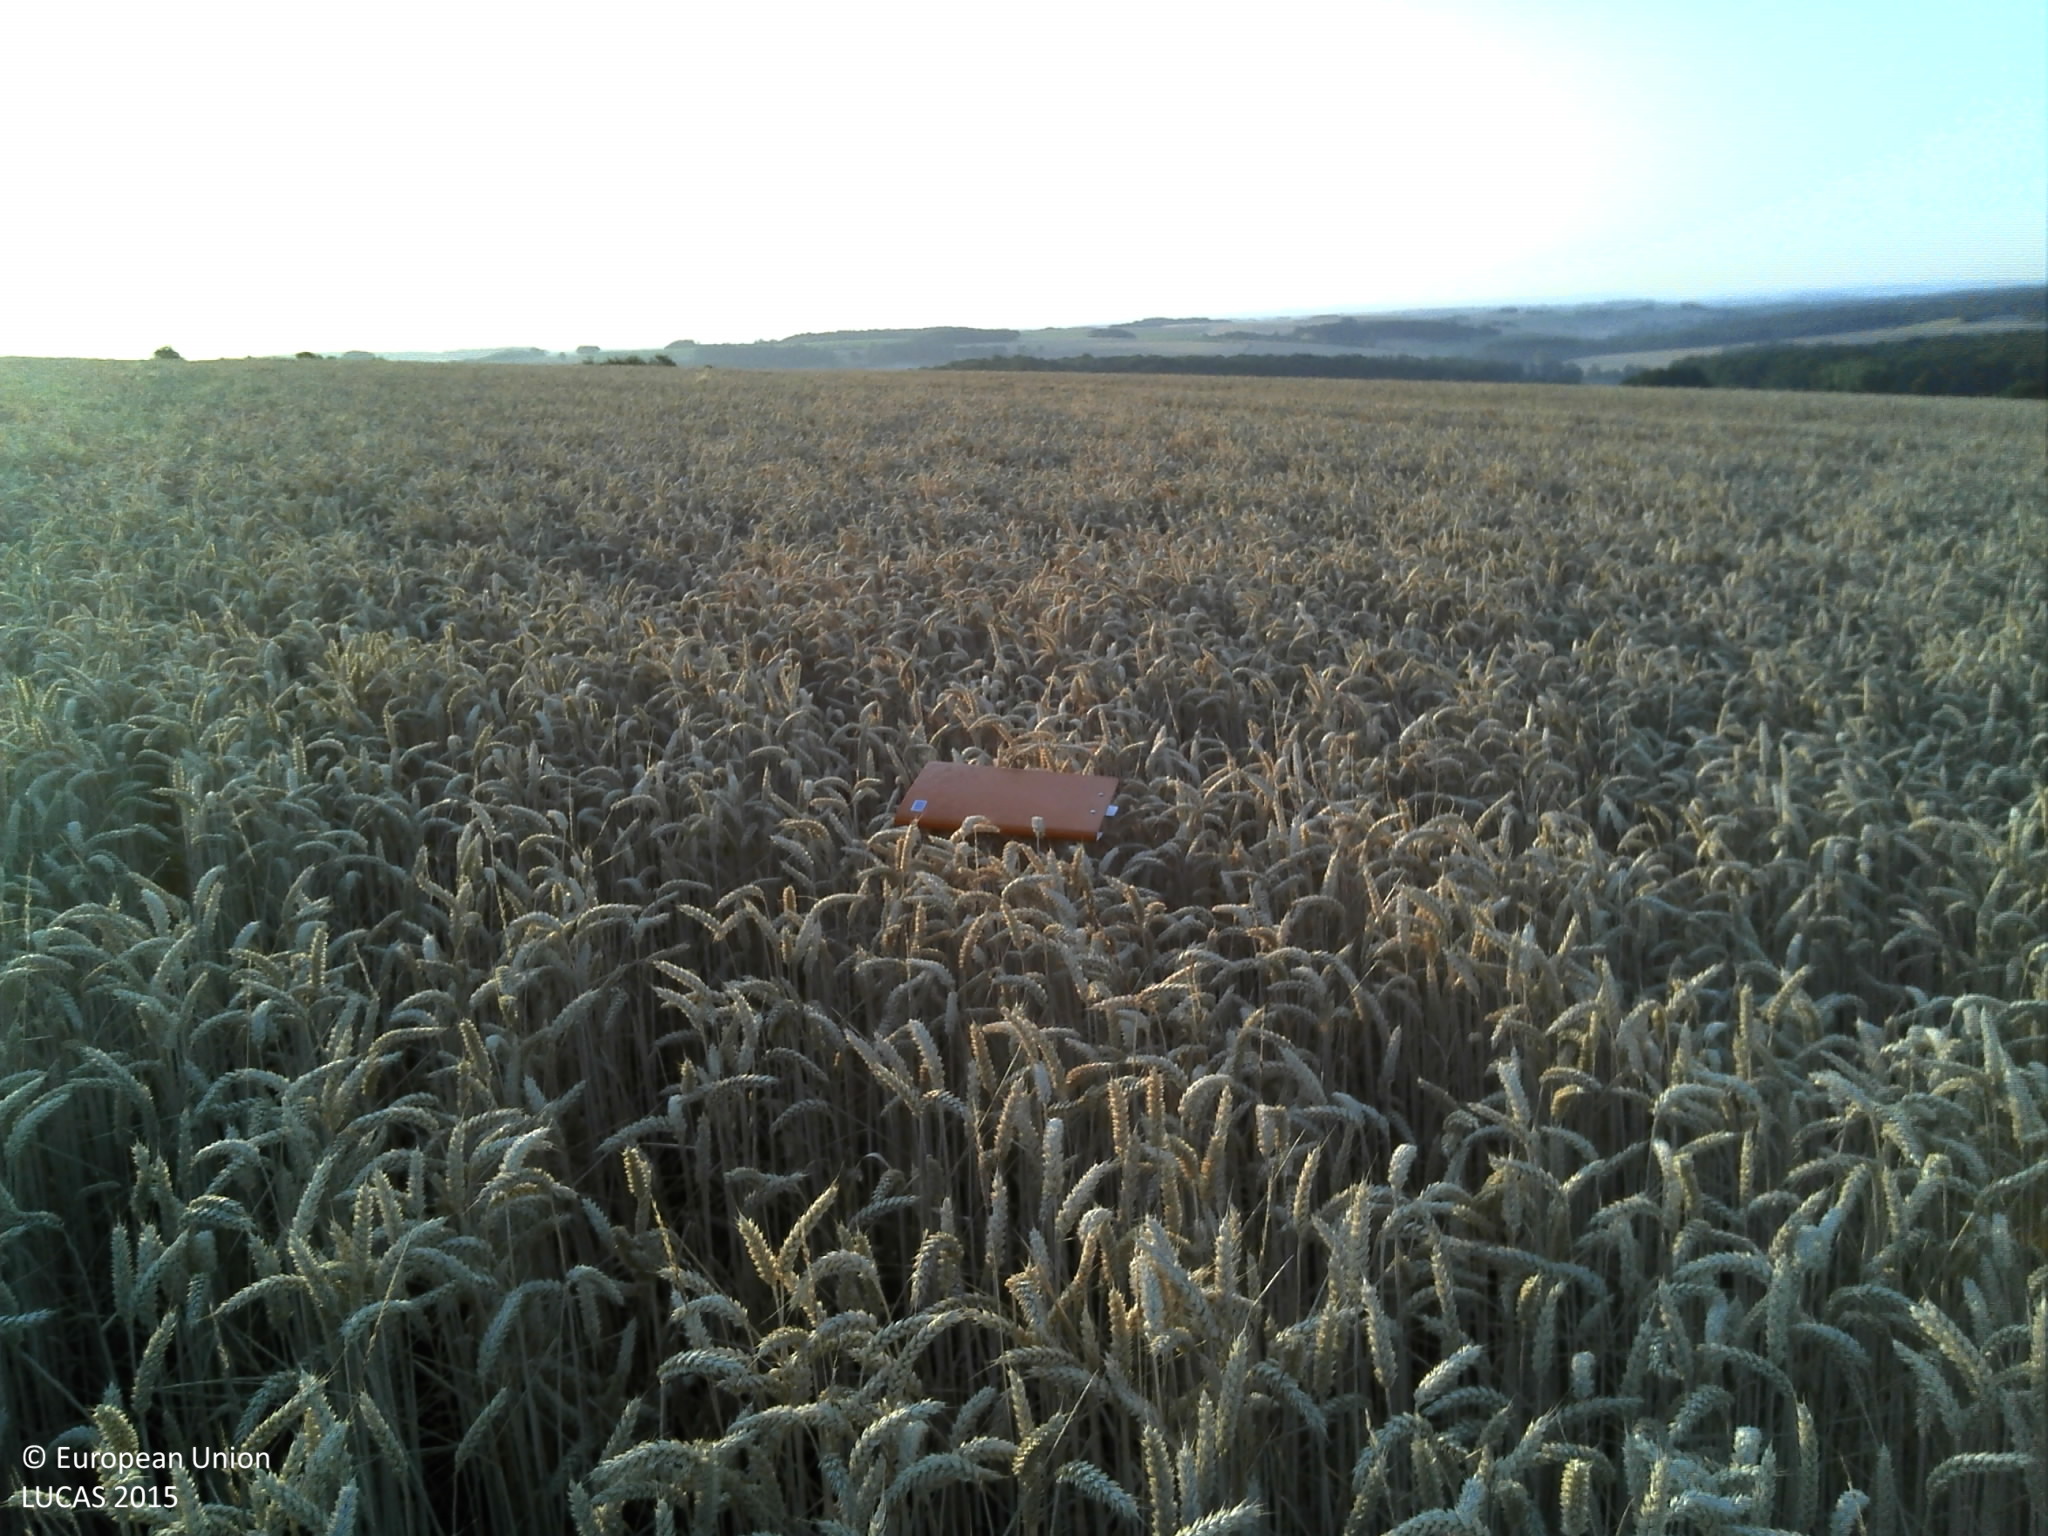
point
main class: Cropland
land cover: Common wheat
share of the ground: > 75 %
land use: Agriculture (excluding fallow land and kitchen gardens)
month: July
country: FR
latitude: 48.1911
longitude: 6.1128
